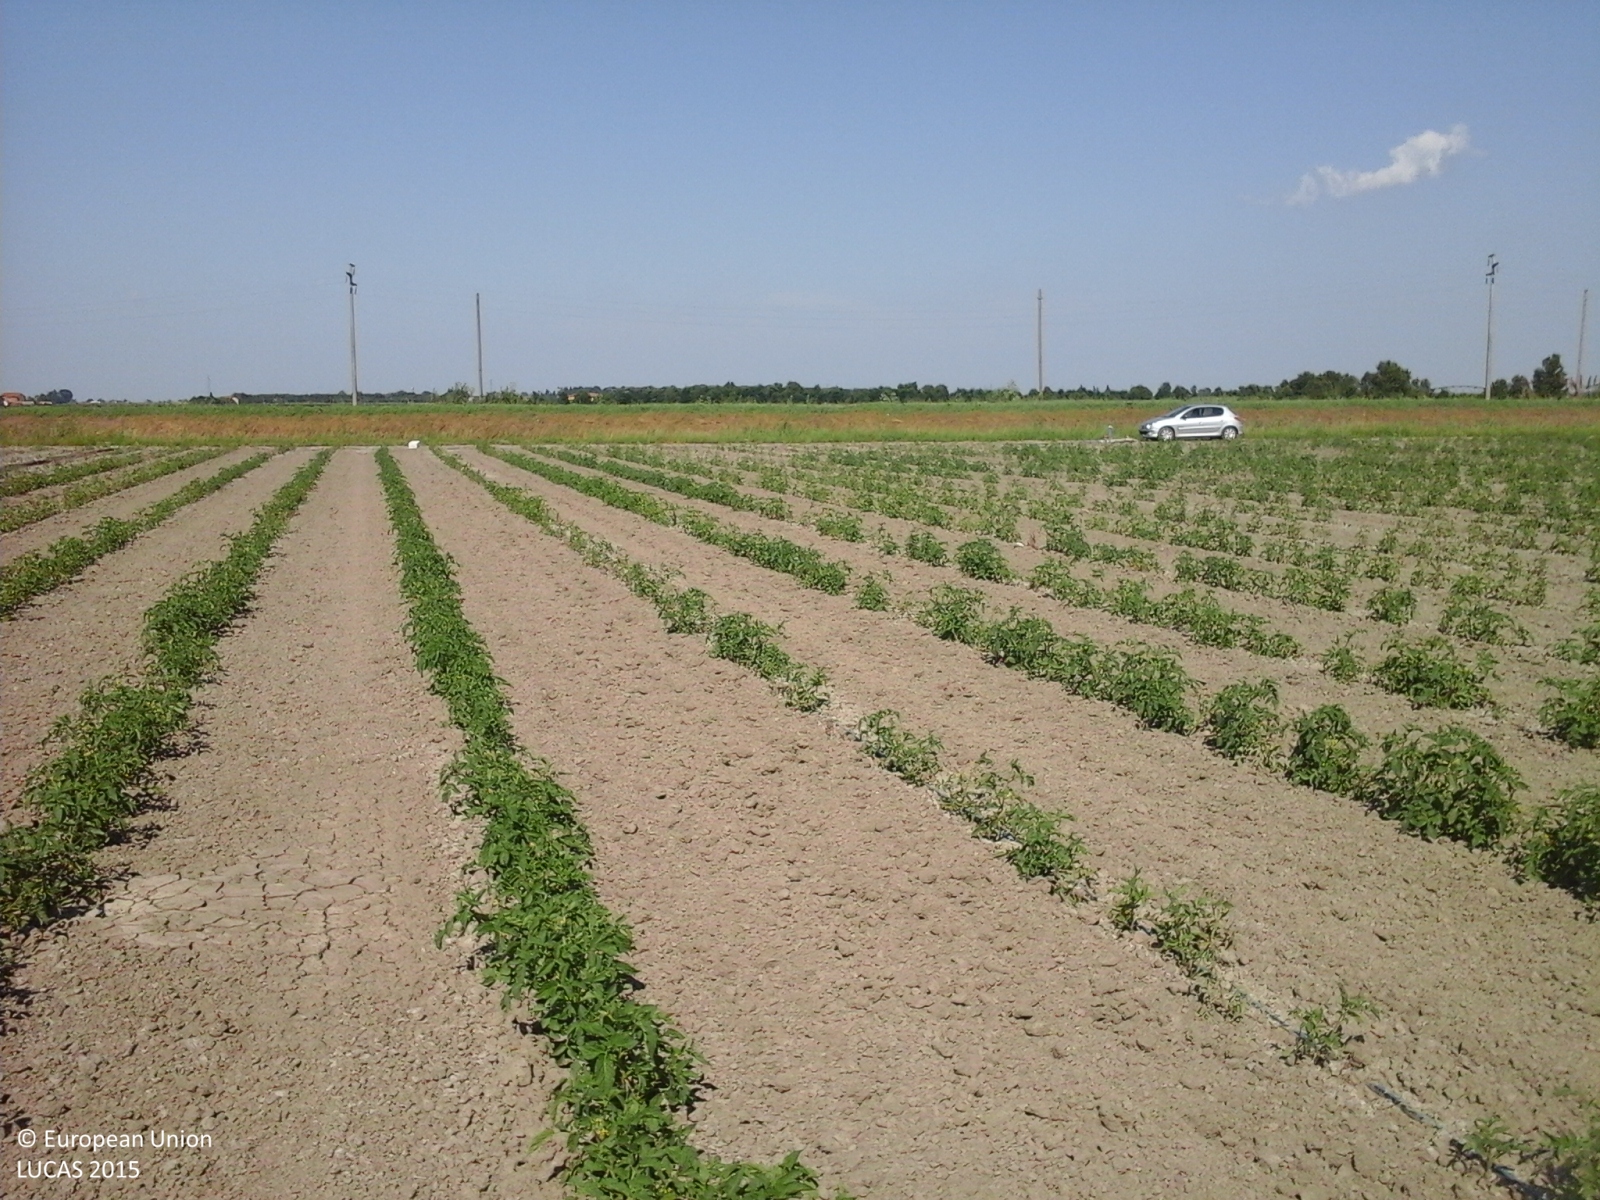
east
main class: Cropland
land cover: Tomatoes
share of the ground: 10 - 25 %
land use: Agriculture (excluding fallow land and kitchen gardens)
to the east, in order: Tomatoes; Tracks; Inland fresh running water; Grass margins; Paved roads, cycling and walking lanes; Grass margins; Electric lines; Lucerne; Electric lines; Lucerne
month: June
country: IT
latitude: 44.6223
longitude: 11.8740
